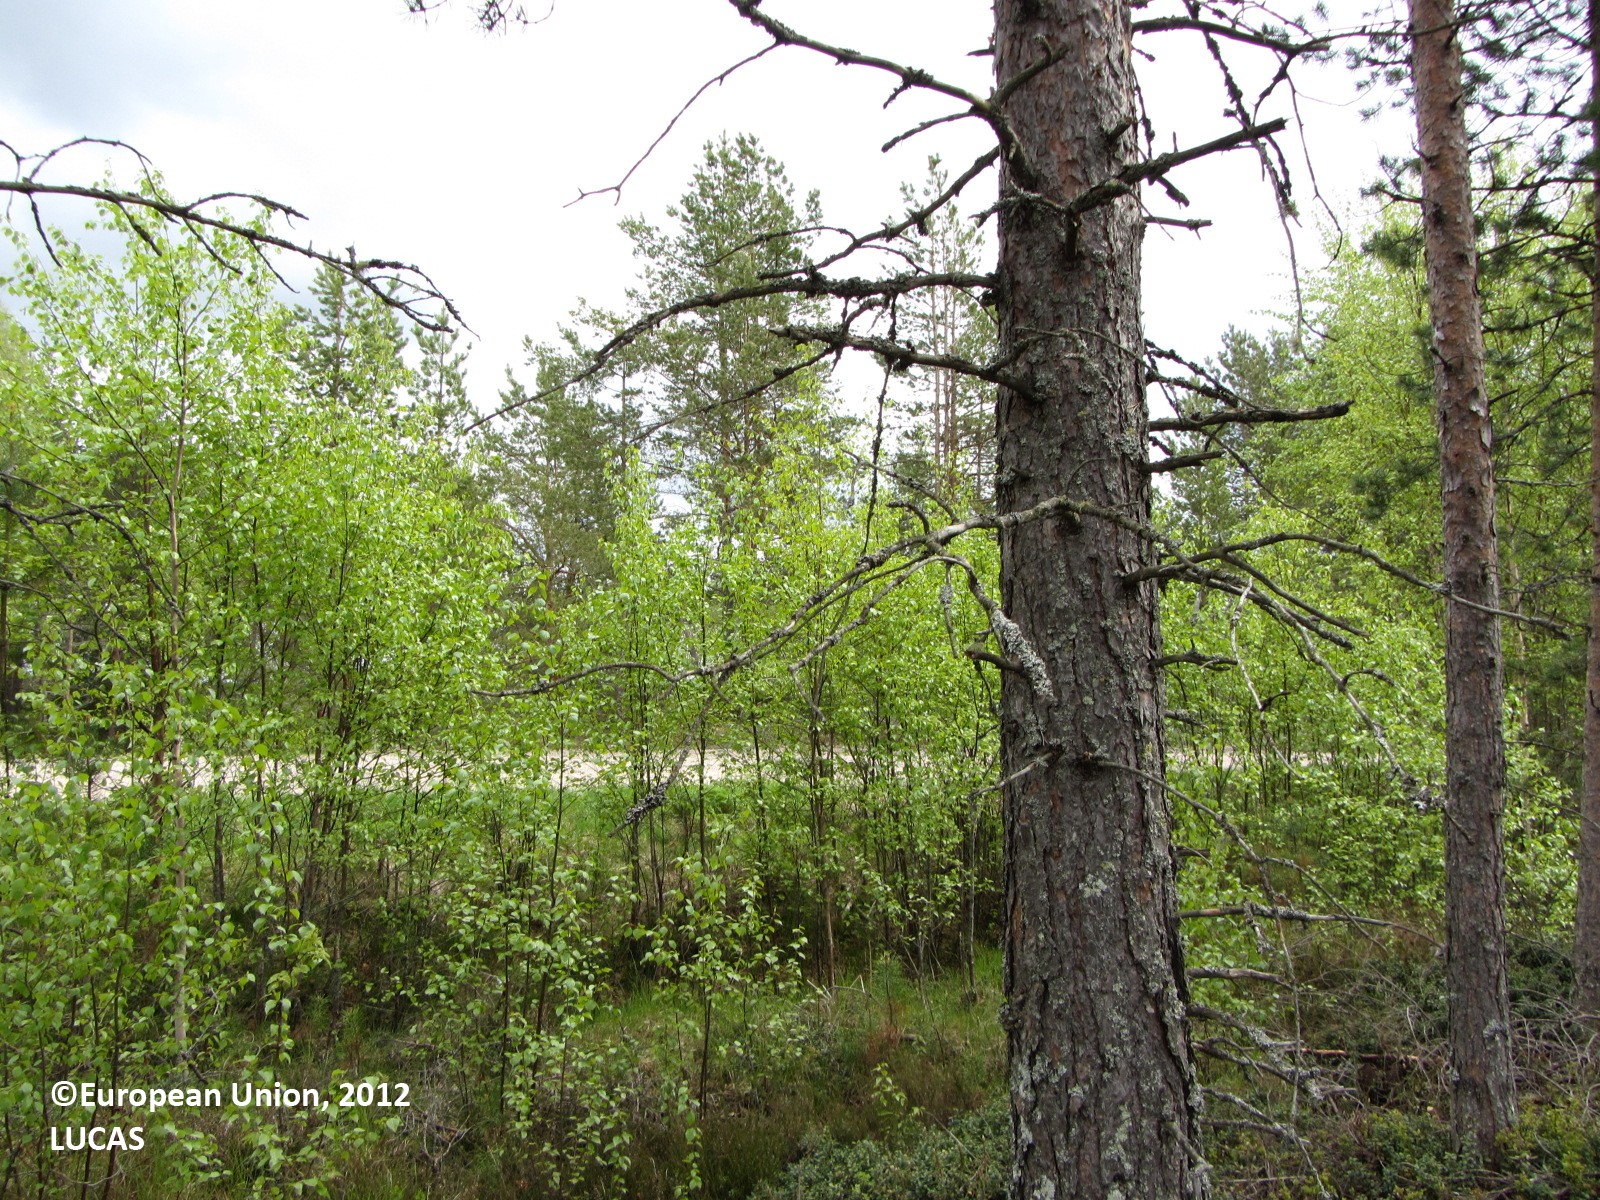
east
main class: Woodland
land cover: Pine dominated coniferous woodland
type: boreal forest
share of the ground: 50 - 75 %
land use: Forestry
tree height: > 5 m
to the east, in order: Pine dominated coniferous woodland; Broadleaved woodland; Grass margins; Paved roads, cycling and walking lanes; Pine dominated coniferous woodland; Sand; Broadleaved woodland; Grassland without tree/shrub cover; Oats
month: June
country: FI
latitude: 63.8027
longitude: 24.6780
